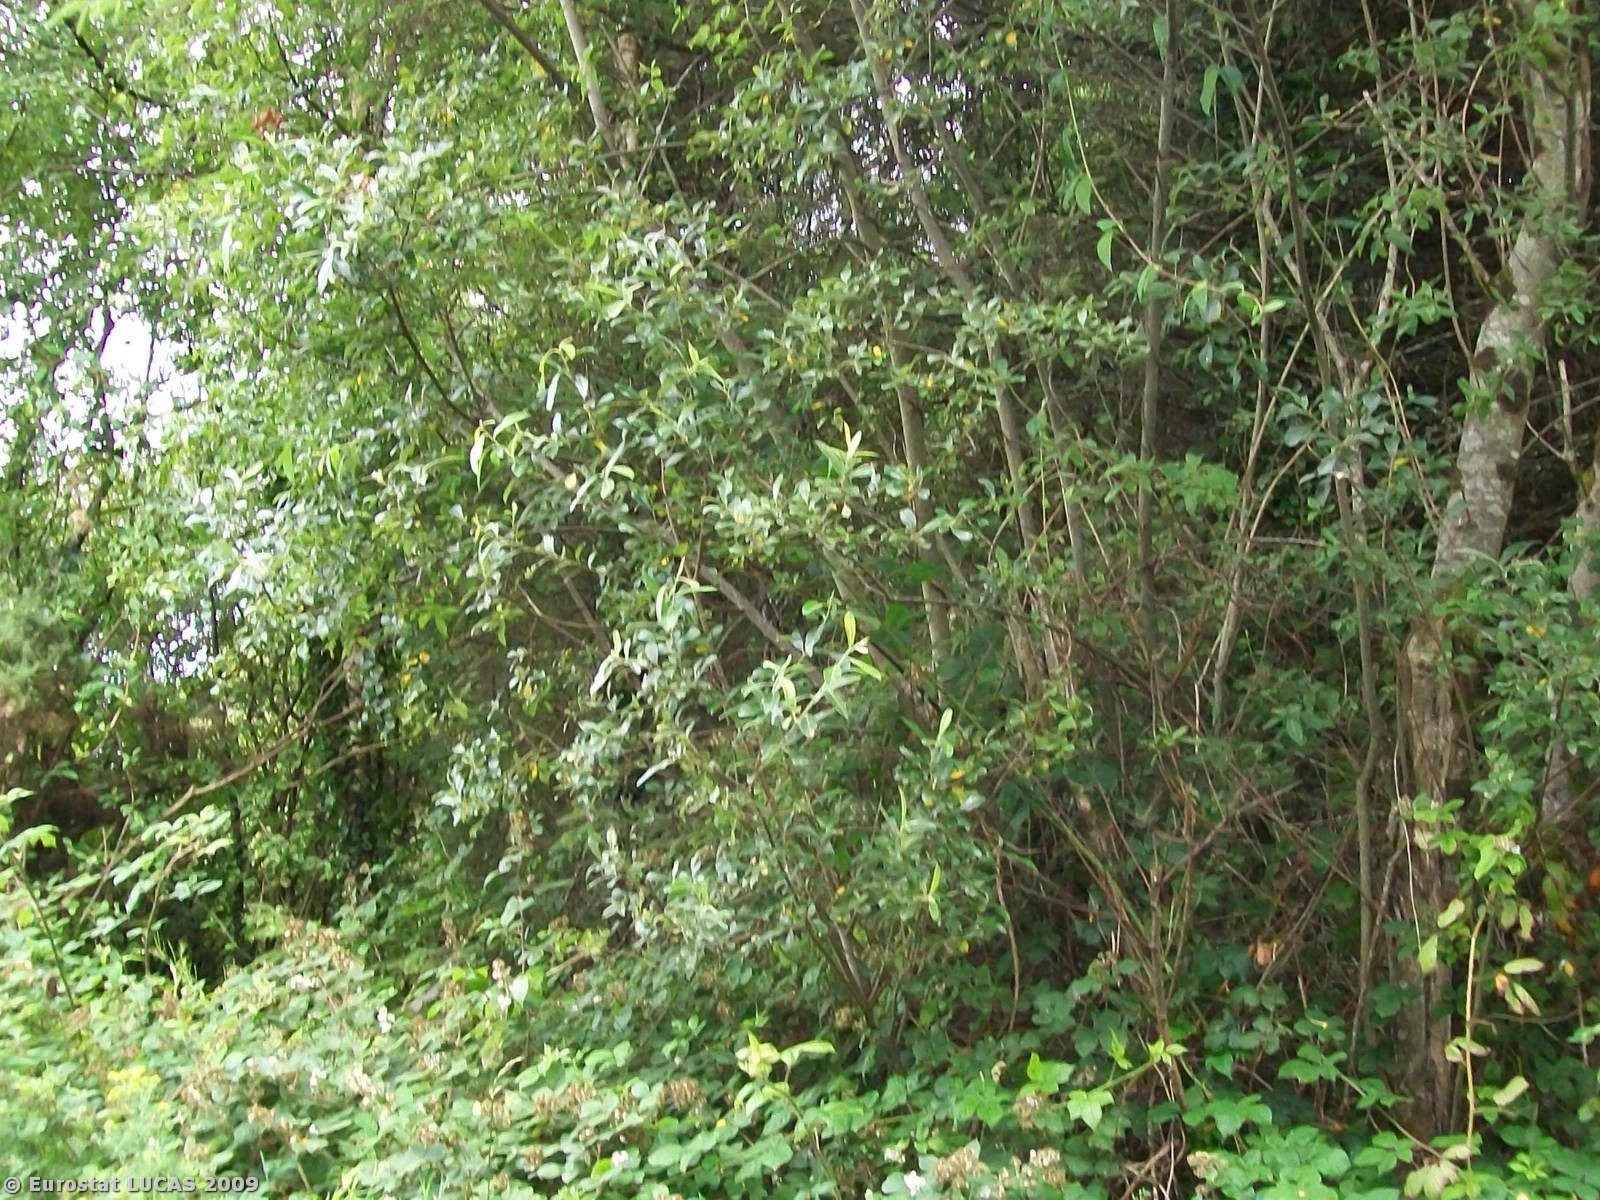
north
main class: Grassland
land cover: Grassland without tree/shrub cover
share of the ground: > 75 %
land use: Agriculture (excluding fallow land and kitchen gardens)
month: July
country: IE
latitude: 53.9705
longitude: -9.1041
